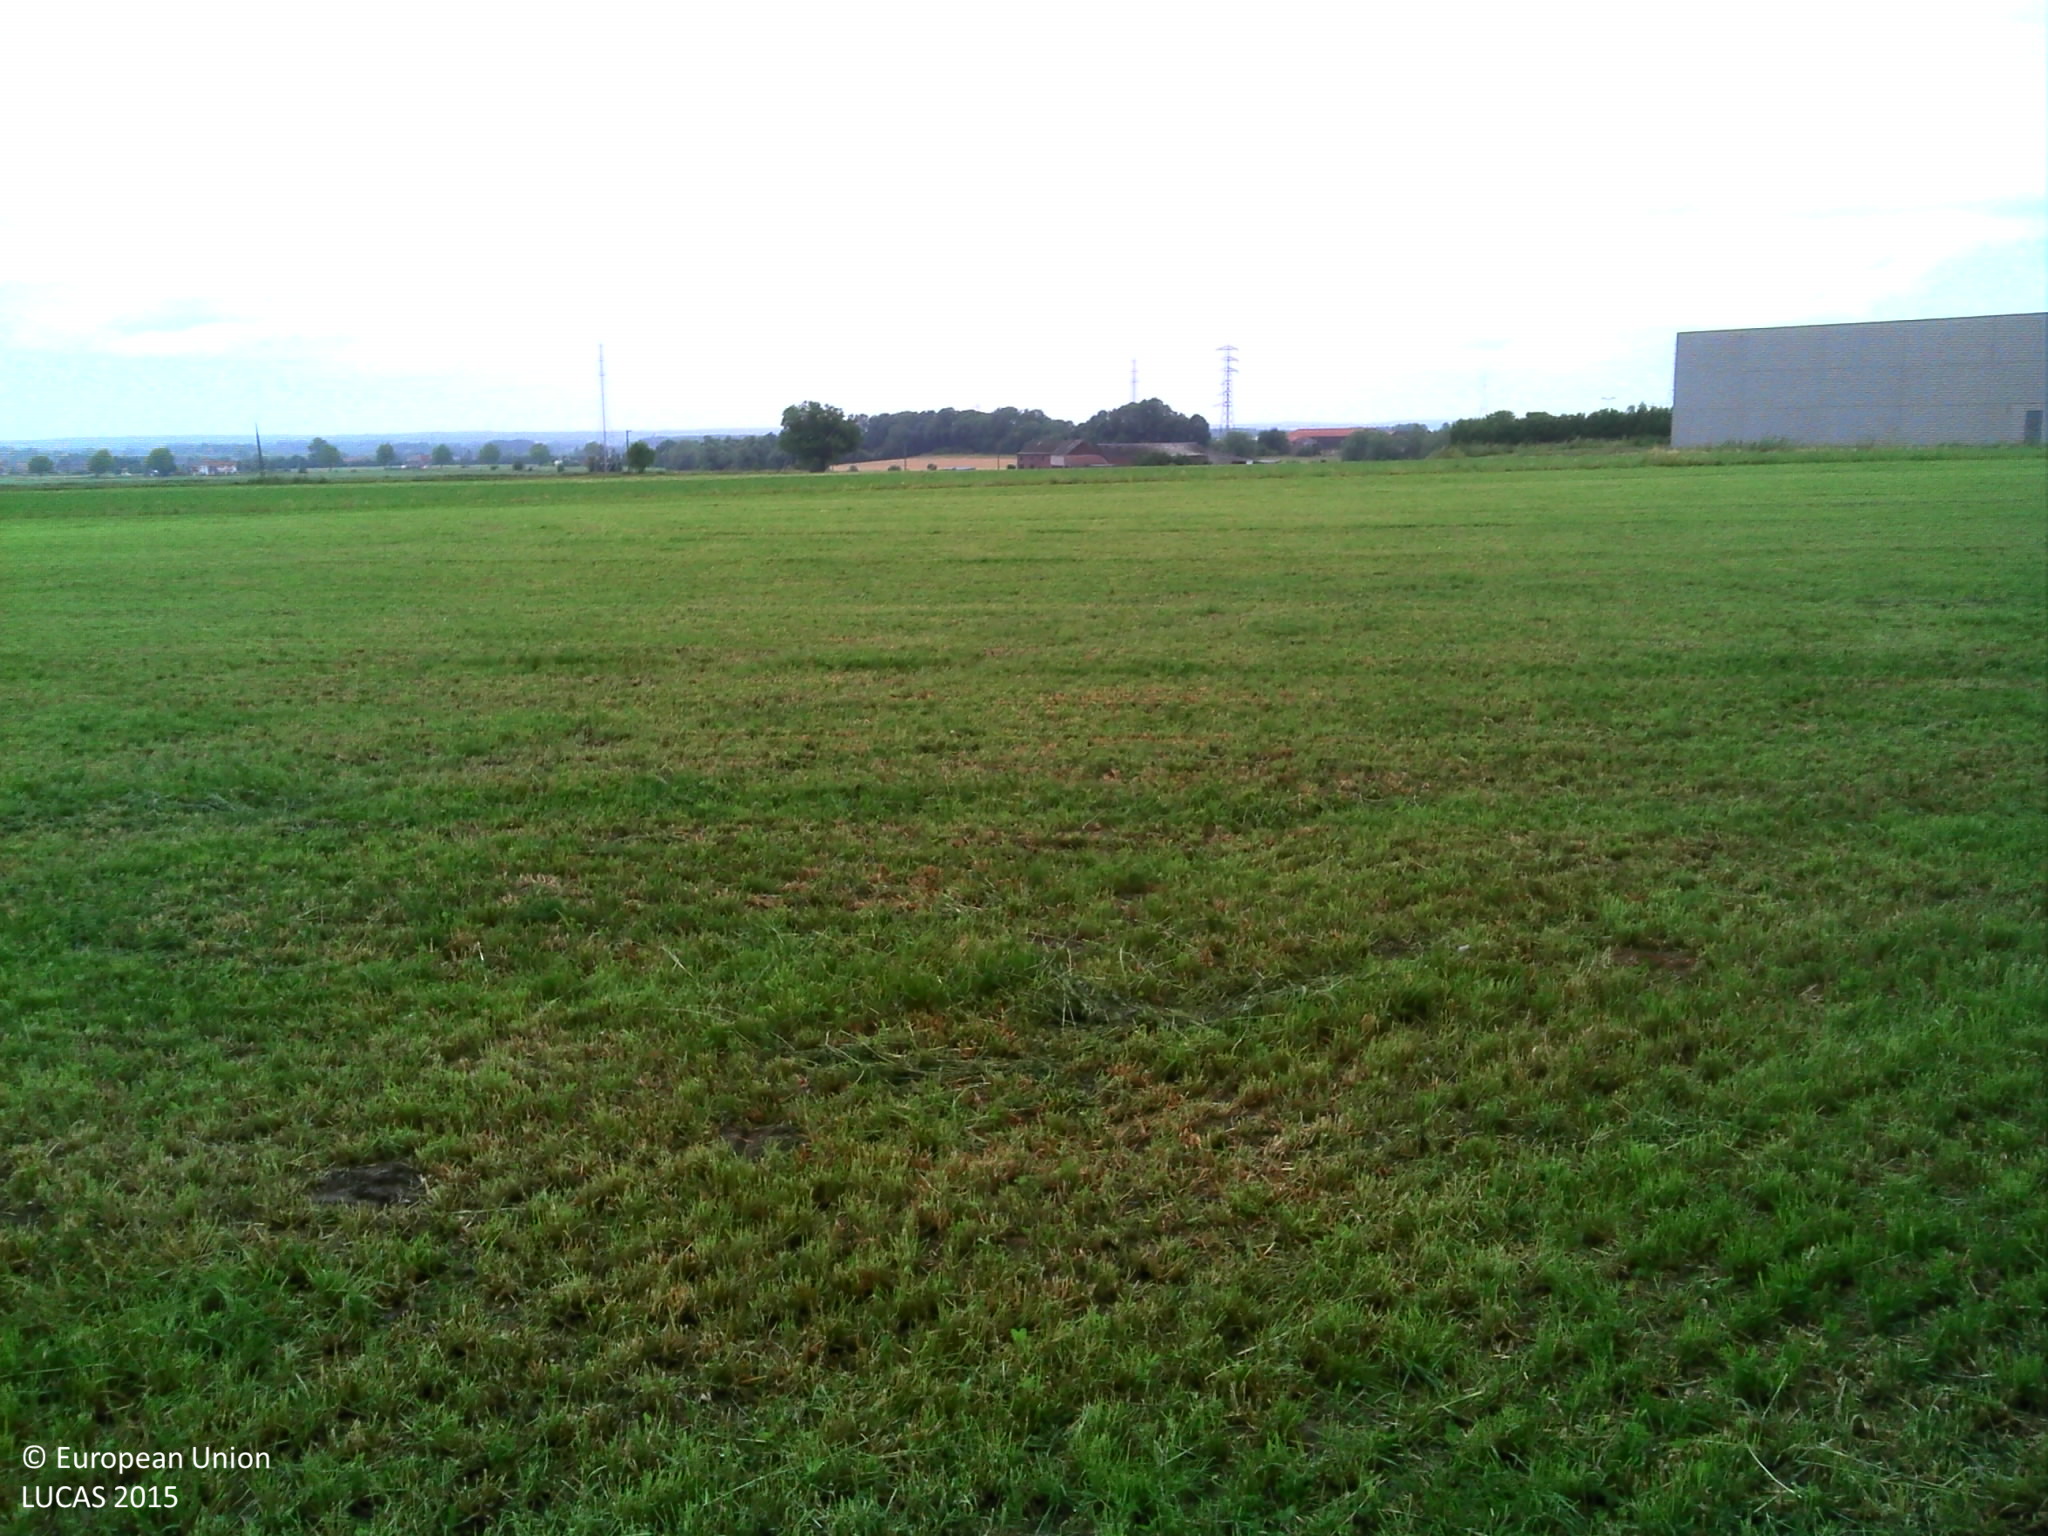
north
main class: Cropland
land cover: Temporary grasslands
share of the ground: > 75 %
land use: Agriculture (excluding fallow land and kitchen gardens)
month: June
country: BE
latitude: 50.4101
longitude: 3.7597
